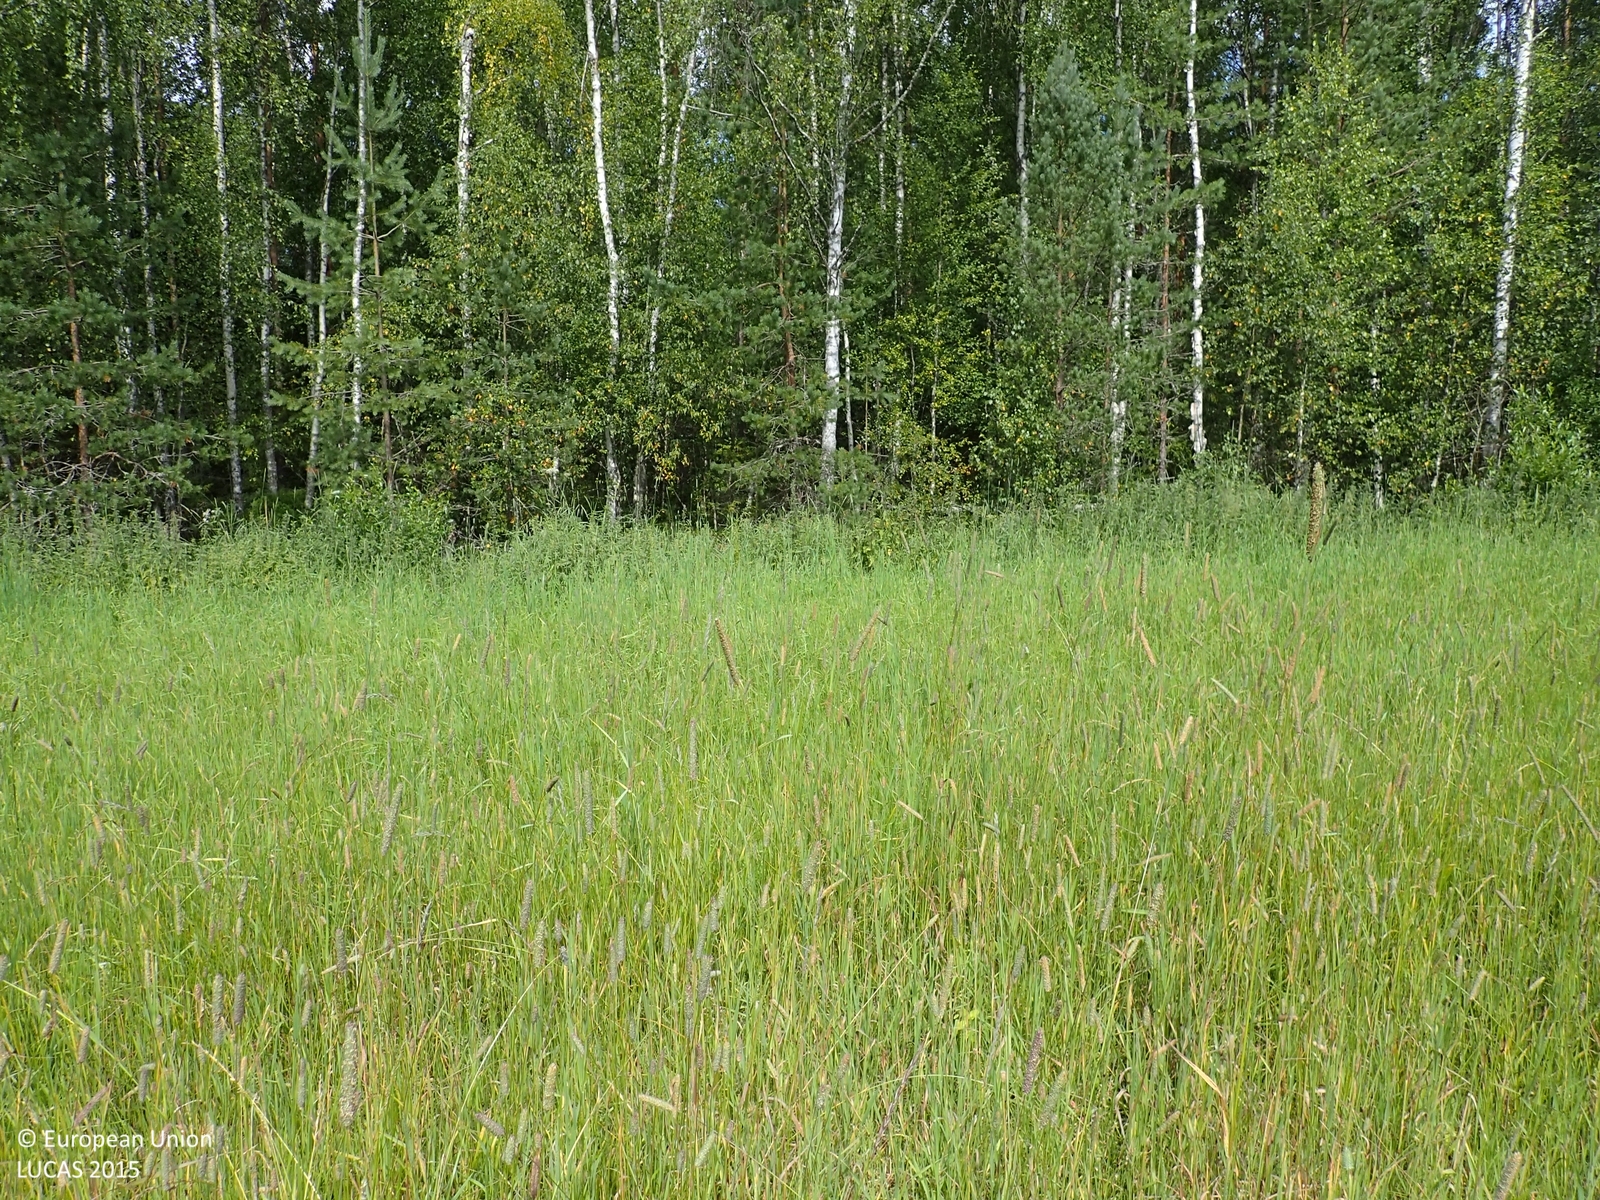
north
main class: Grassland
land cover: Spontaneously vegetated surfaces
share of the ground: > 75 %
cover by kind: herbaceous plants 100 %
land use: Fallow land
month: August
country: FI
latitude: 62.8374
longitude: 21.8451
